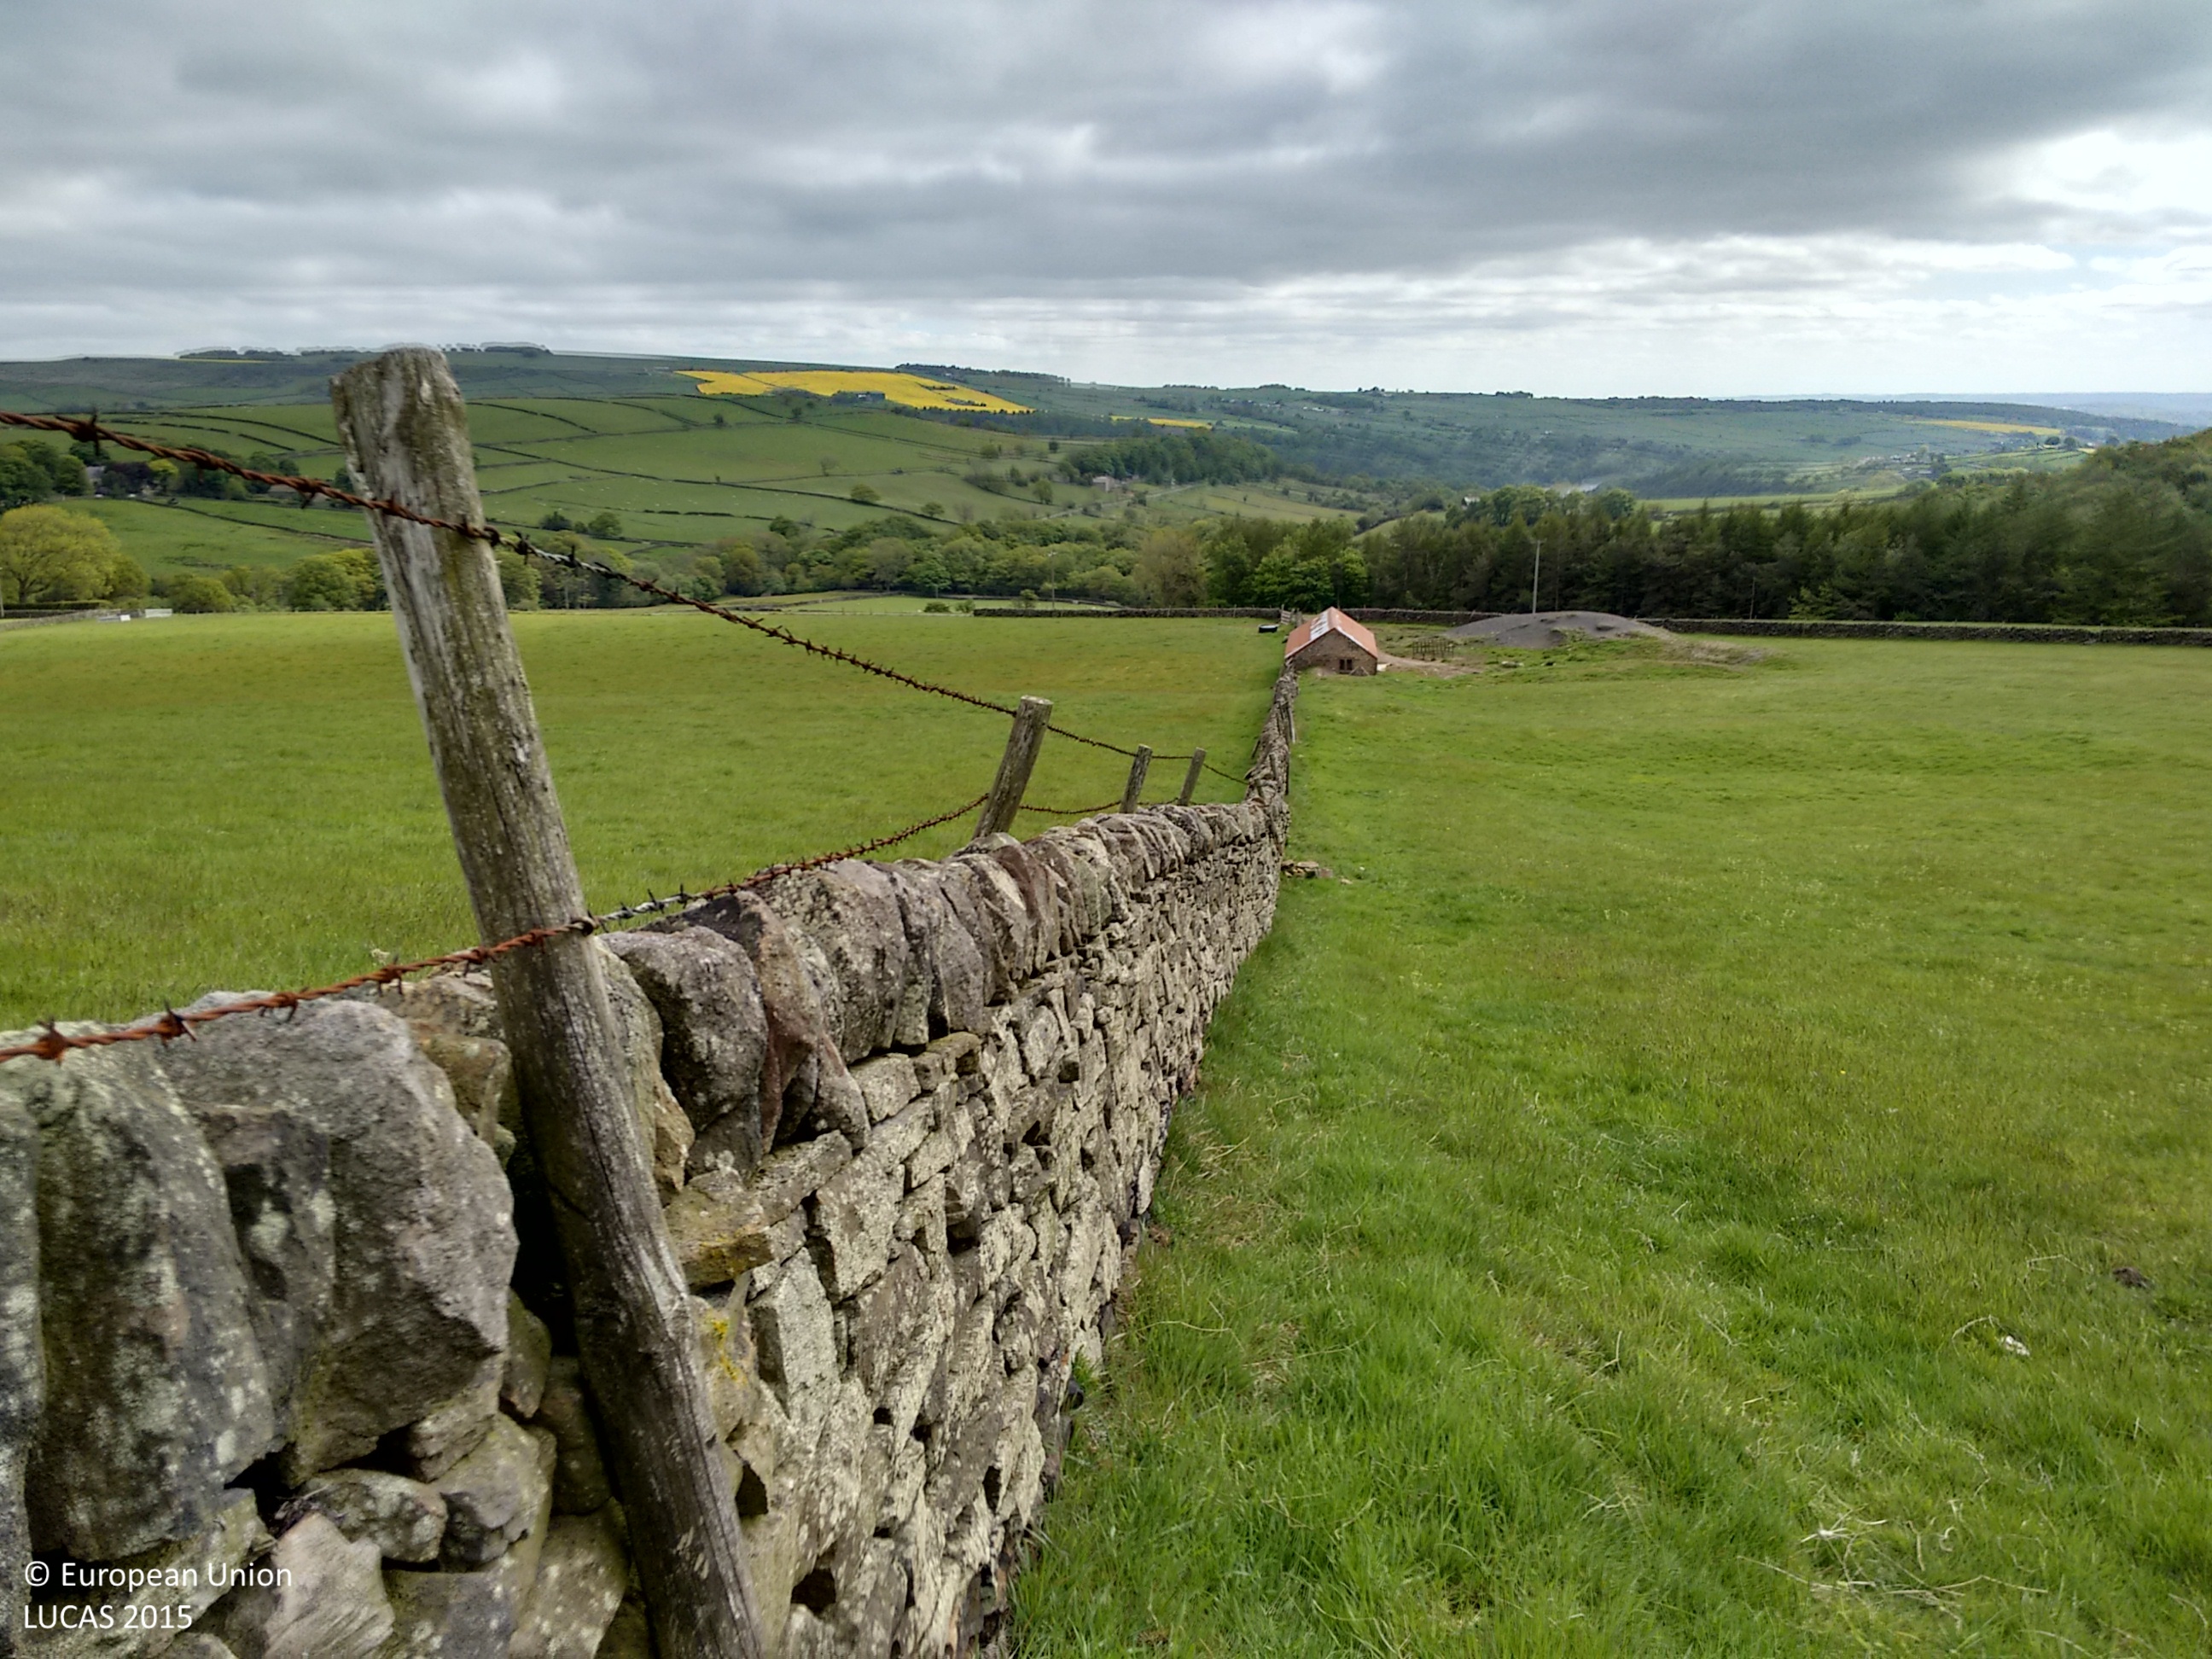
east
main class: Grassland
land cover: Grassland without tree/shrub cover
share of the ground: > 75 %
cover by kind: herbaceous plants 100 %
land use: Agriculture (excluding fallow land and kitchen gardens)
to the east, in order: Grassland without tree/shrub cover; Dry stone walls; Fences; Grassland without tree/shrub cover; Fences; Dry stone walls; Electric lines; Grass margins; Tracks; Grassland without tree/shrub cover; Fences; Pine dominated coniferous woodland
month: May
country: GB
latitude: 53.4038
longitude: -1.6187
